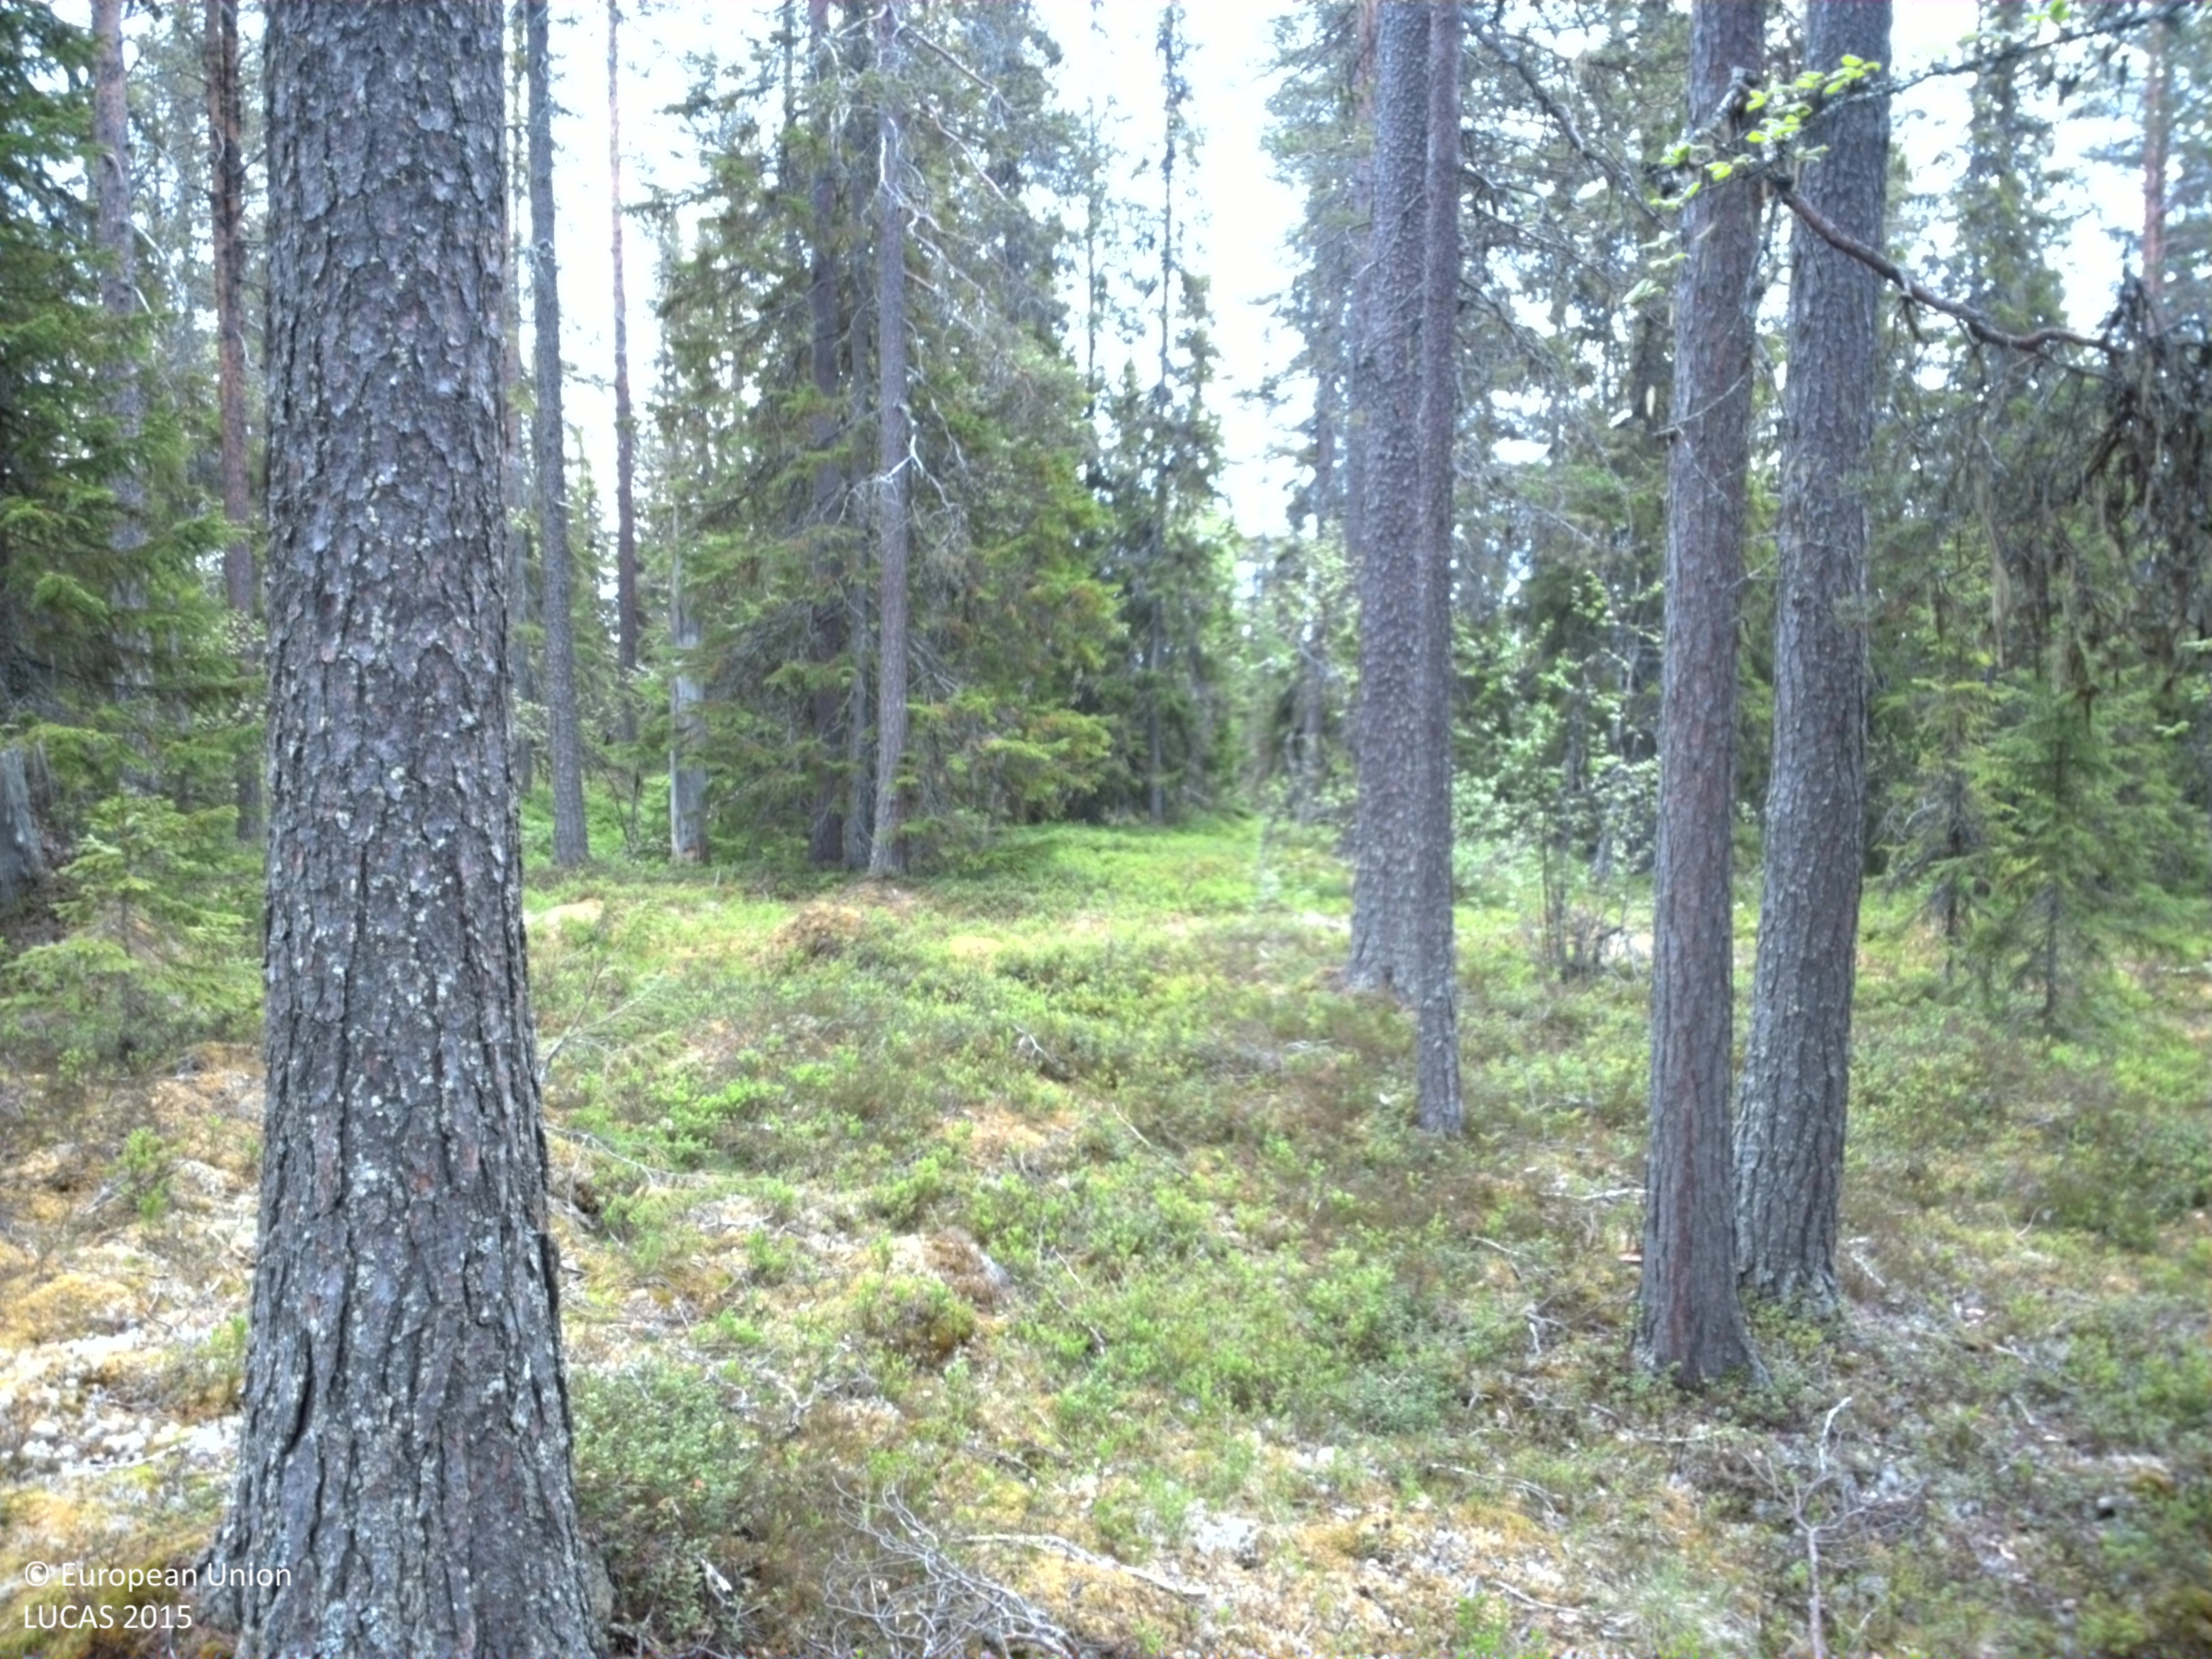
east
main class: Woodland
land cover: Pine dominated mixed woodland
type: boreal forest
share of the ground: 50 - 75 %
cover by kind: coniferous forest trees 45 %, broadleaved forest trees 25 %, shrubs 20 %, lichens and mosses 10 %
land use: Forestry
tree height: > 5 m
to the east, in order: Pine dominated mixed woodland; Other mixed woodland; Spruce dominated mixed woodland
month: June
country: SE
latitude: 61.7734
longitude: 13.6819
